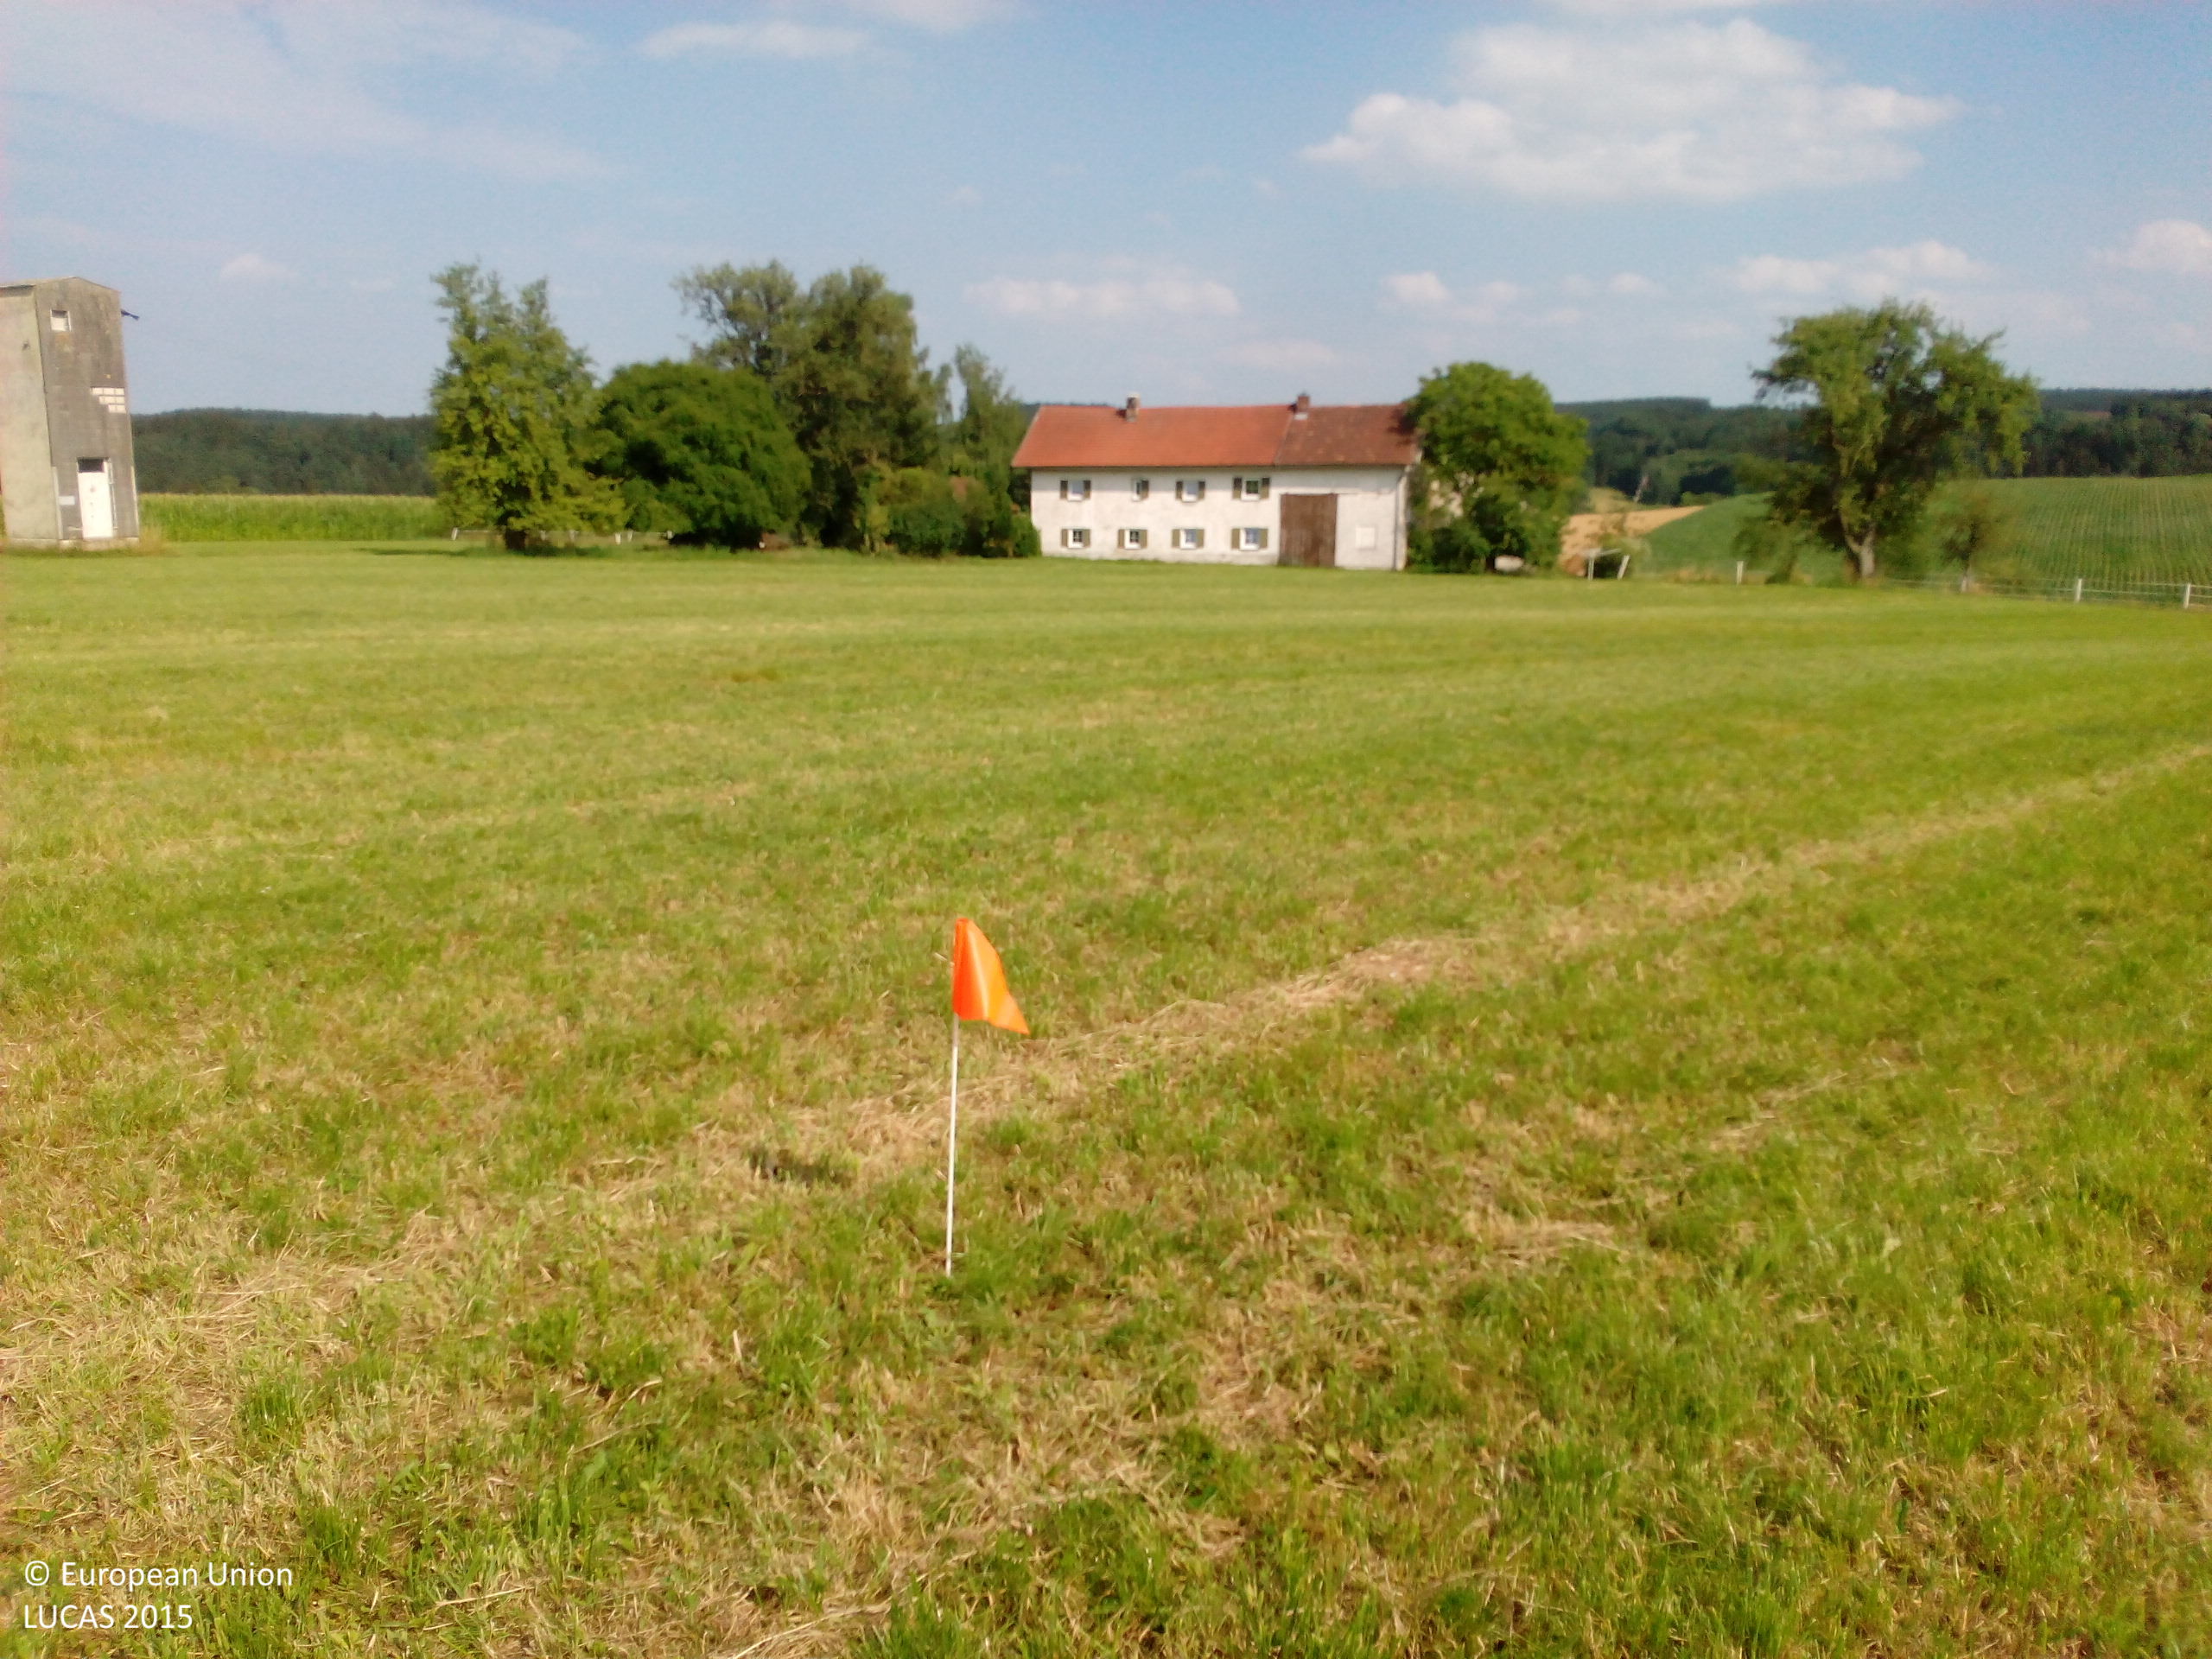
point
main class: Grassland
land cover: Grassland without tree/shrub cover
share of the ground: > 75 %
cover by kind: herbaceous plants 100 %
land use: Agriculture (excluding fallow land and kitchen gardens)
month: July
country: DE
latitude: 48.3834
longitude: 12.9022
